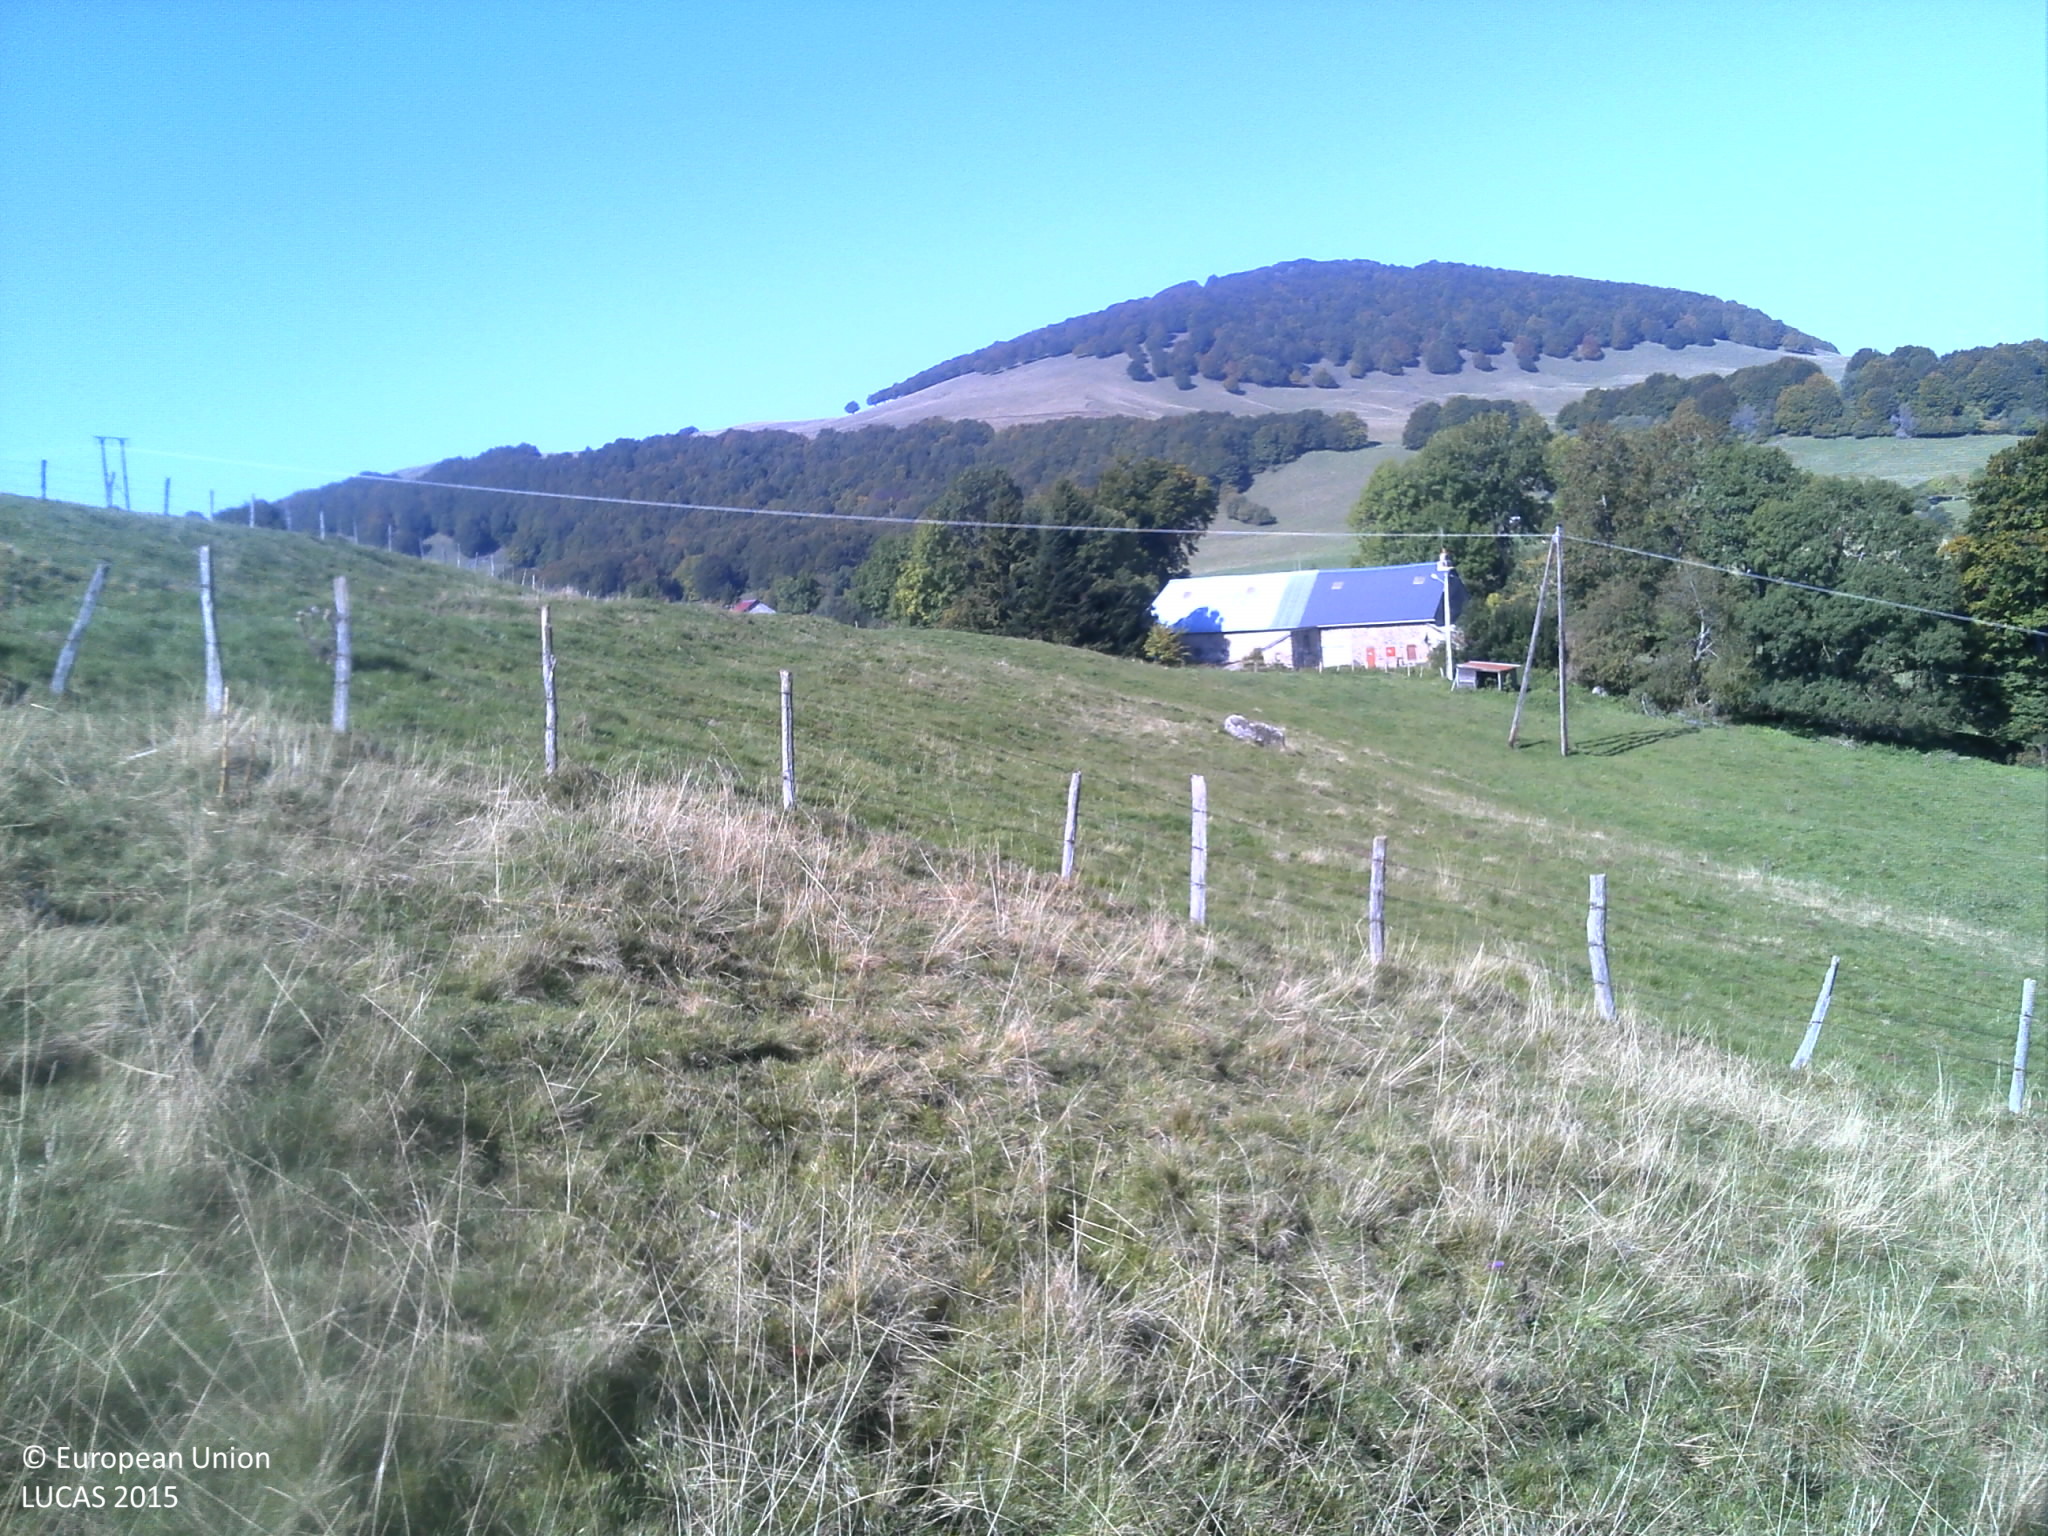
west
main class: Grassland
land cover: Grassland without tree/shrub cover
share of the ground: > 75 %
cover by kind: herbaceous plants 100 %
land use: Agriculture (excluding fallow land and kitchen gardens)
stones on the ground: < 10 %
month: October
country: FR
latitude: 45.4284
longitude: 2.9066
